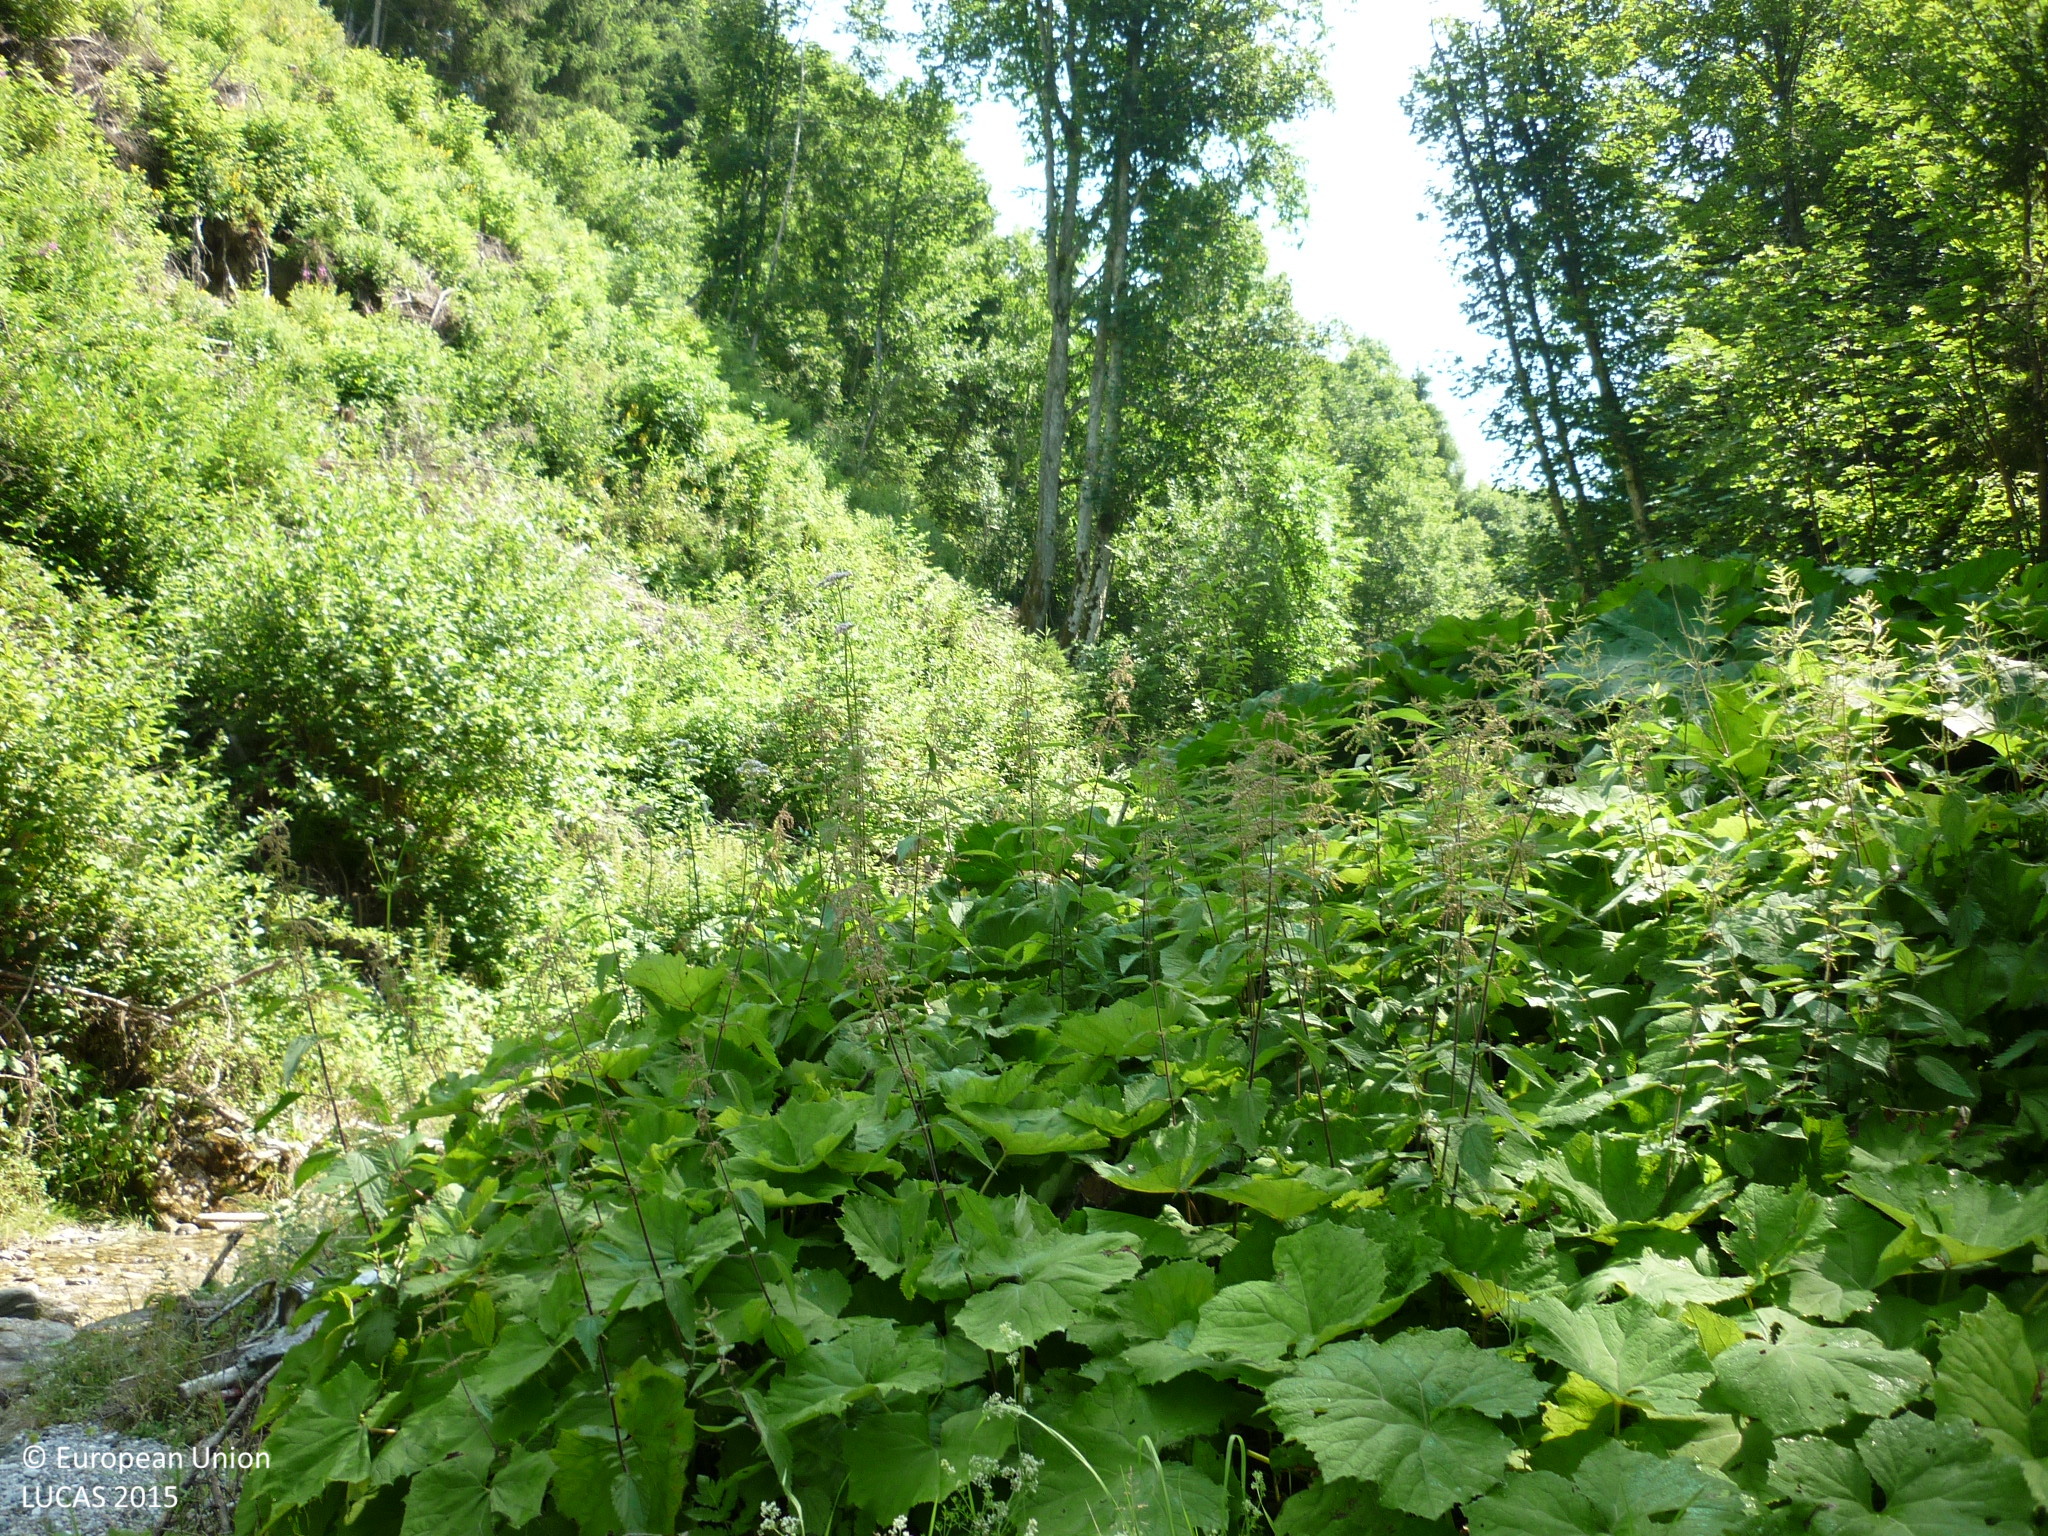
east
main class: Grassland
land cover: Spontaneously vegetated surfaces
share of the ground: > 75 %
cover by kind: herbaceous plants 80 %, unconsolidated bare surface 15 %, shrubs 5 %
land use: Semi-natural and natural areas not in use
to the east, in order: Spontaneously vegetated surfaces; Rivers and streams; Shrubland with sparse tree cover; Broadleaved woodland; Grassland without tree/shrub cover; Broadleaved woodland; Electric lines; Grassland without tree/shrub cover
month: July
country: AT
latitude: 47.4265
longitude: 13.5909
